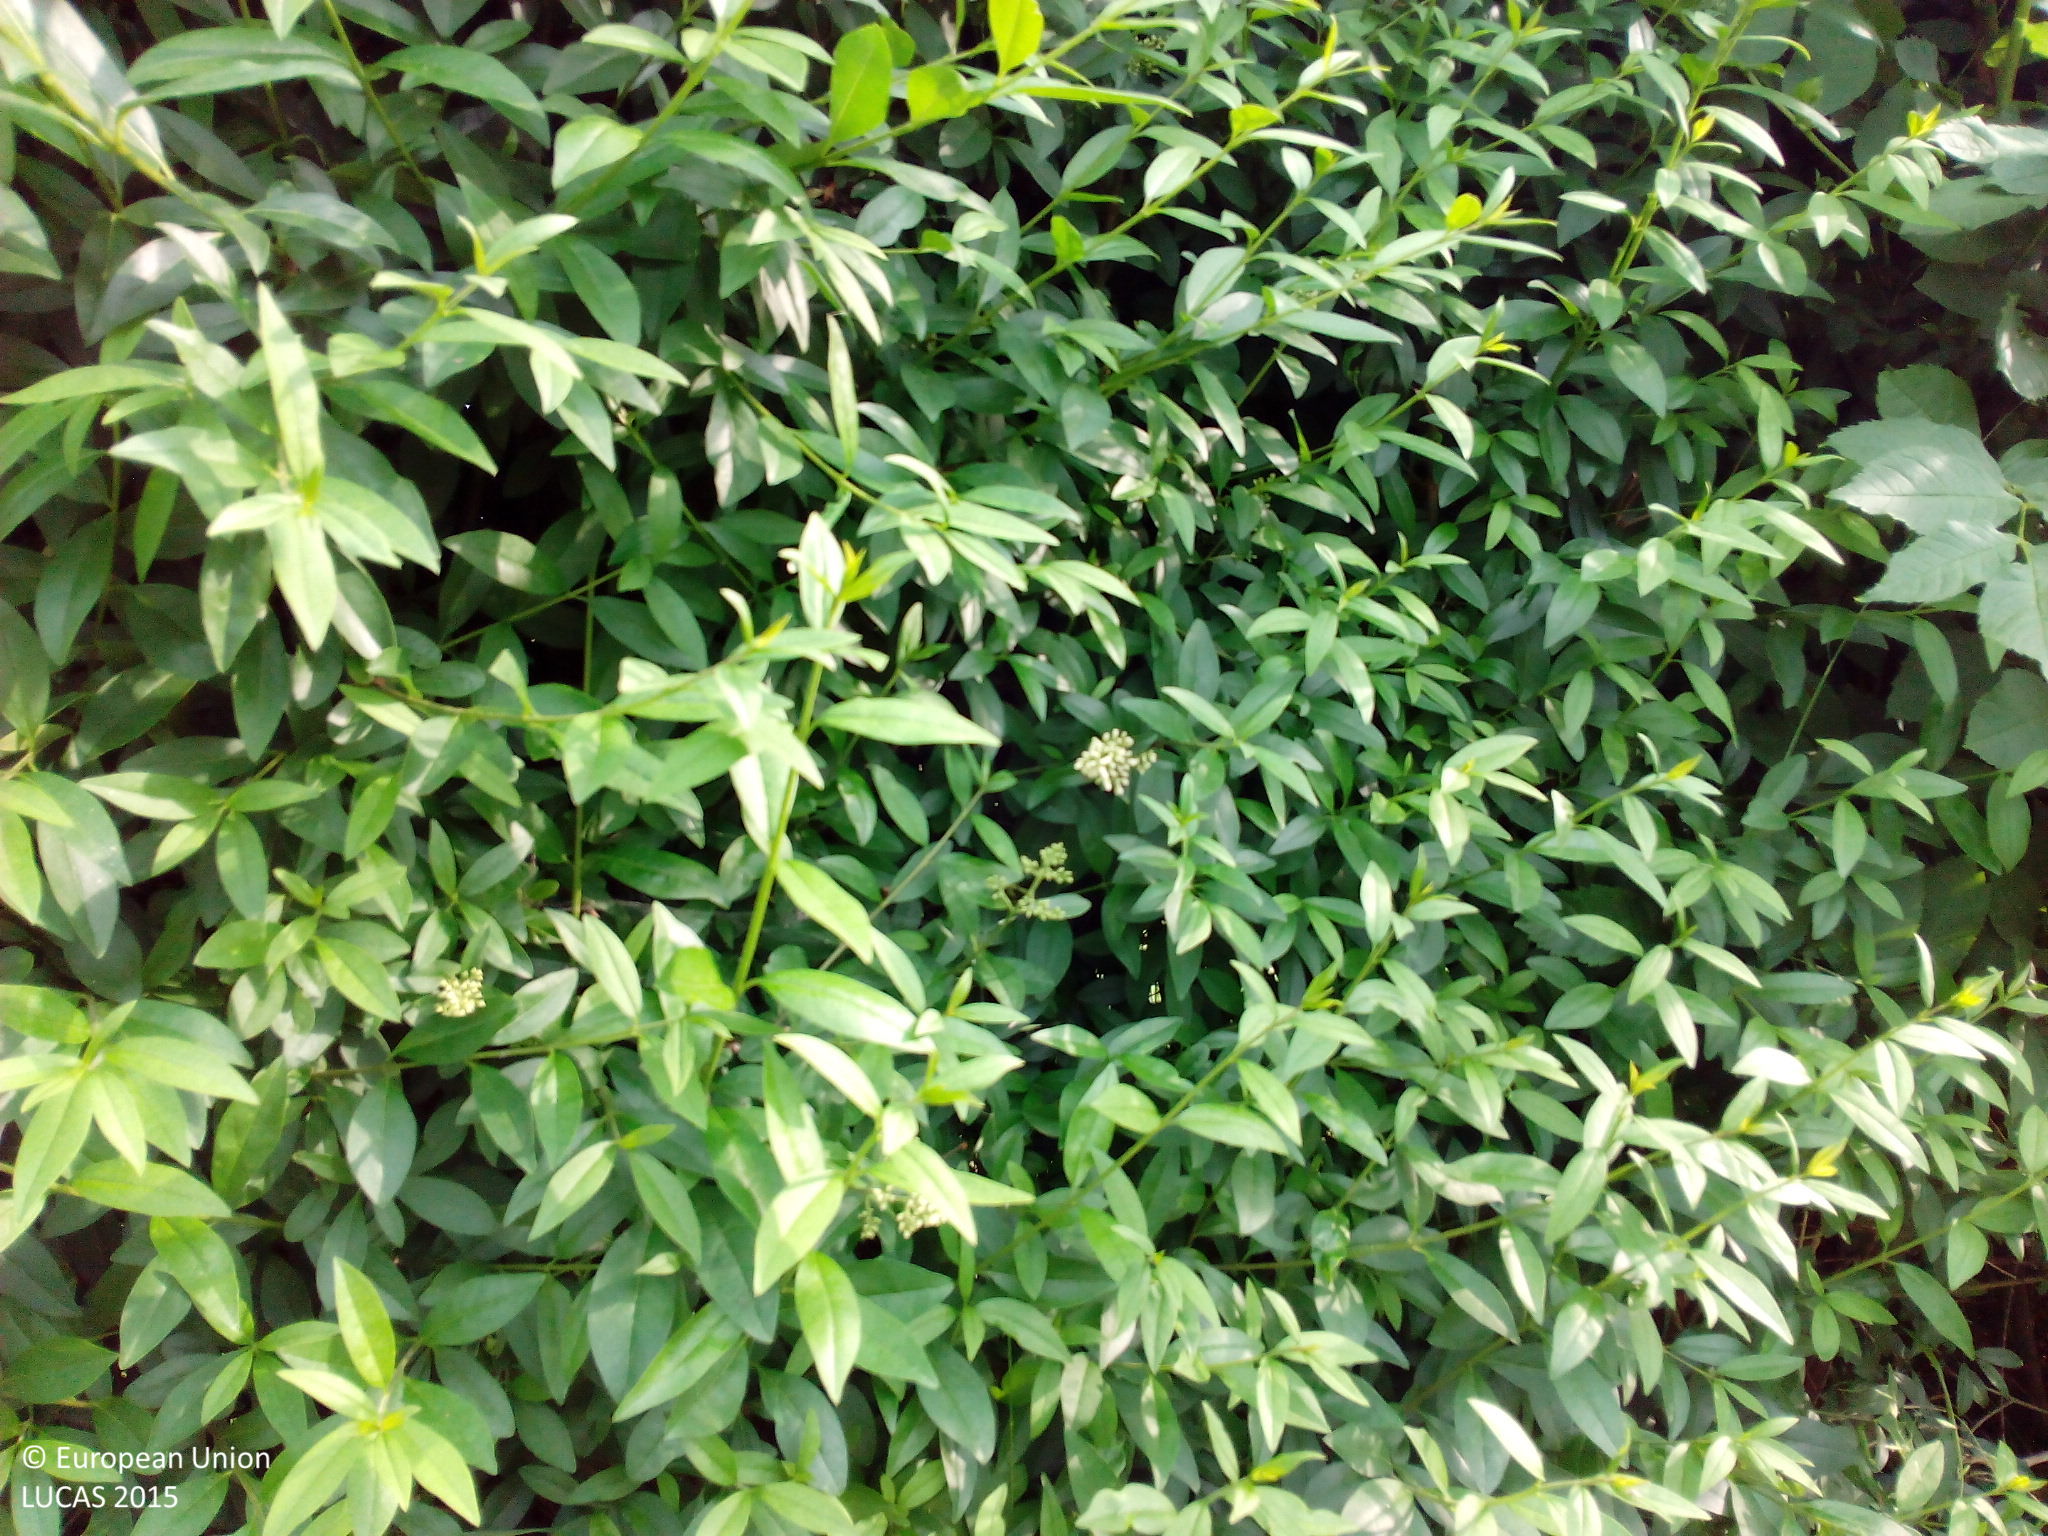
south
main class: Grassland
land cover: Grassland without tree/shrub cover
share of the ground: > 75 %
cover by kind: herbaceous plants 100 %
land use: Semi-natural and natural areas not in use
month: June
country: DE
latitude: 48.6358
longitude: 9.4168
